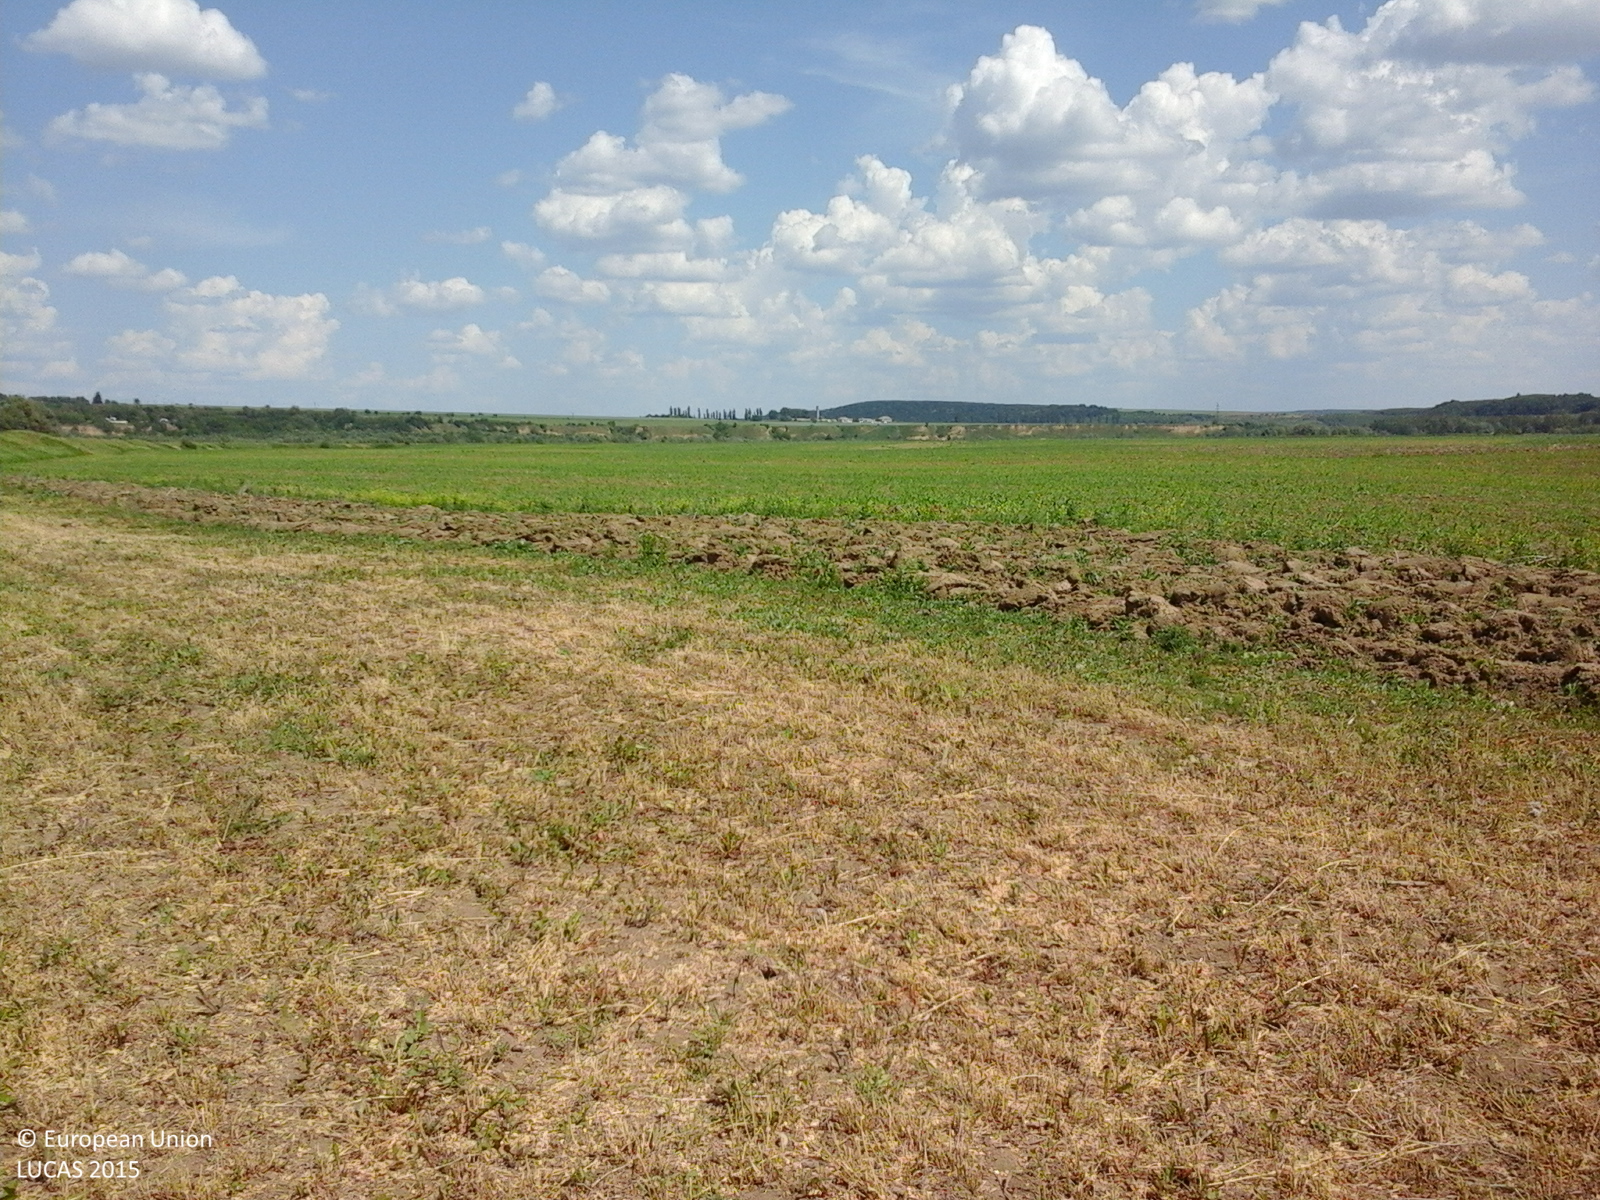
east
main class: Cropland
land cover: Lucerne
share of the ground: 10 - 25 %
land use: Agriculture (excluding fallow land and kitchen gardens)
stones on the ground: < 10 %
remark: Harvested field
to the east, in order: Lucerne; Other bare soil; Maize
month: June
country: RO
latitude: 46.7735
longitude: 26.9241
